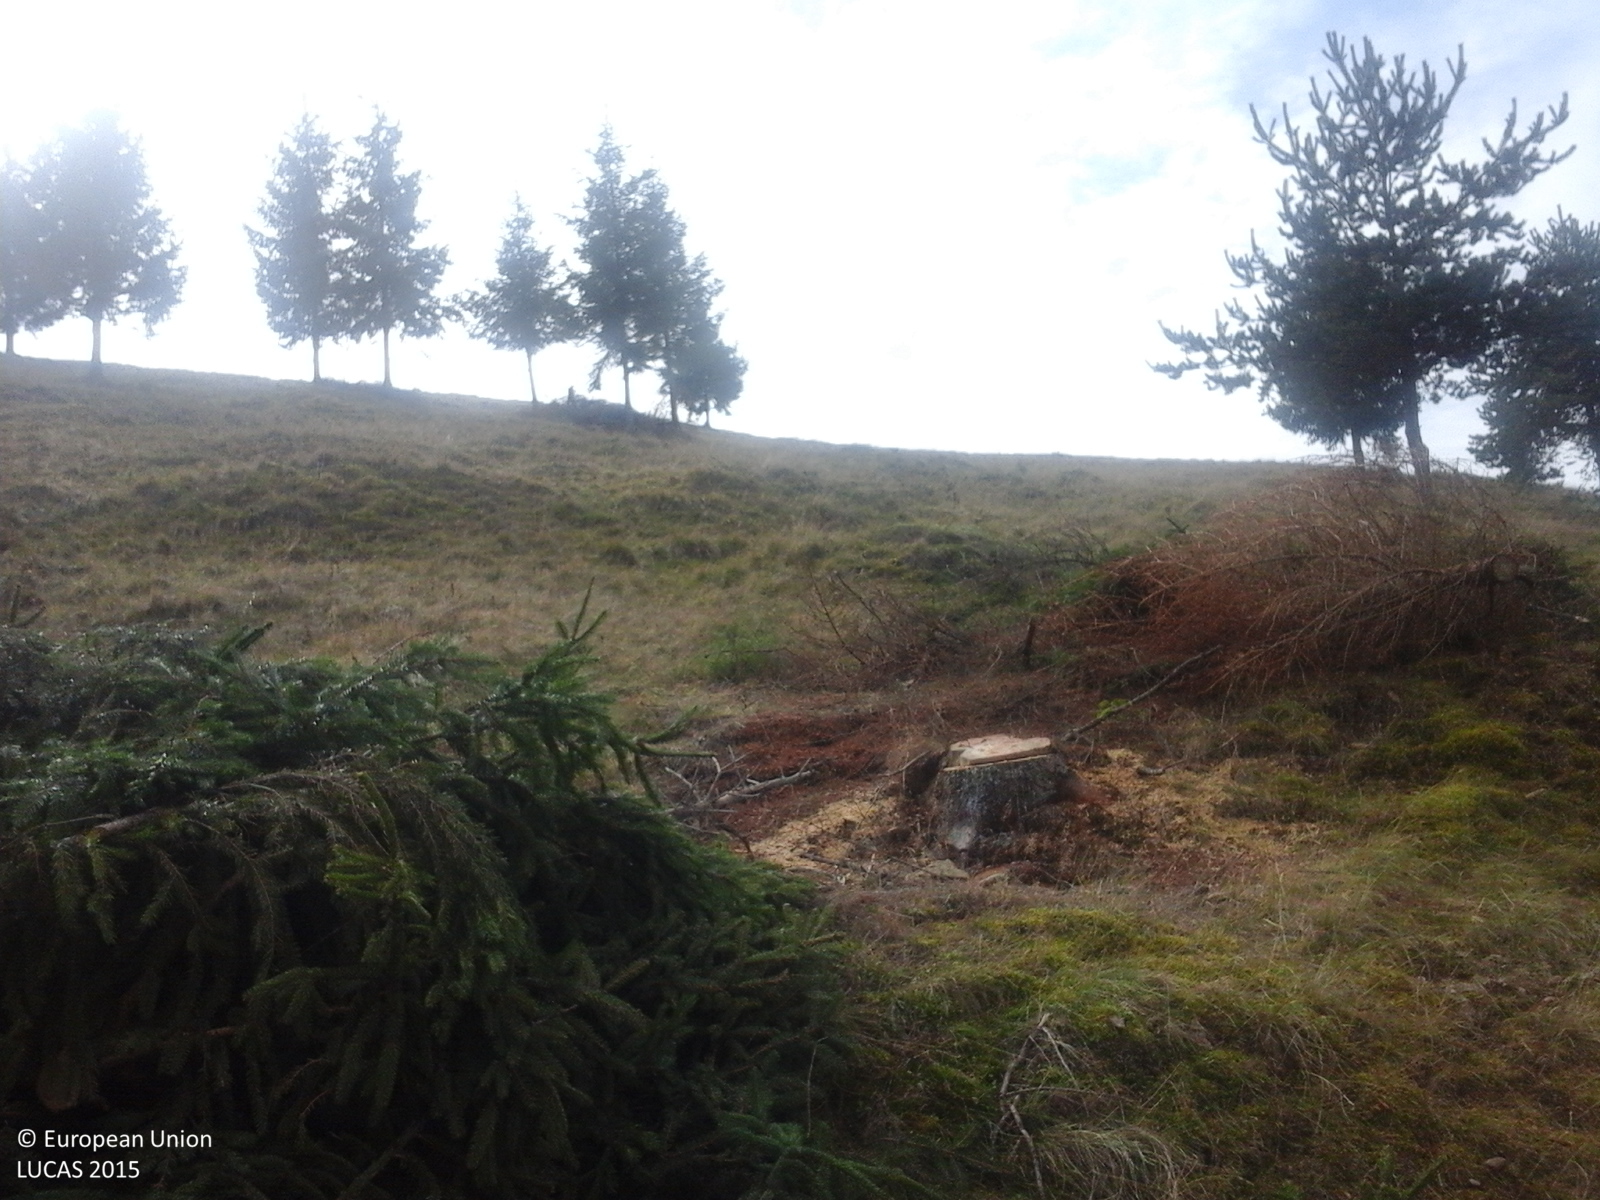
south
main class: Grassland
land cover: Grassland with sparse tree/shrub cover
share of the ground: > 75 %
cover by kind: herbaceous plants 85 %, shrubs 10 %, broadleaved forest trees 5 %
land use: Fallow land
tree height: > 5 m
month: October
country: RO
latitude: 46.4957
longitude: 25.8701
